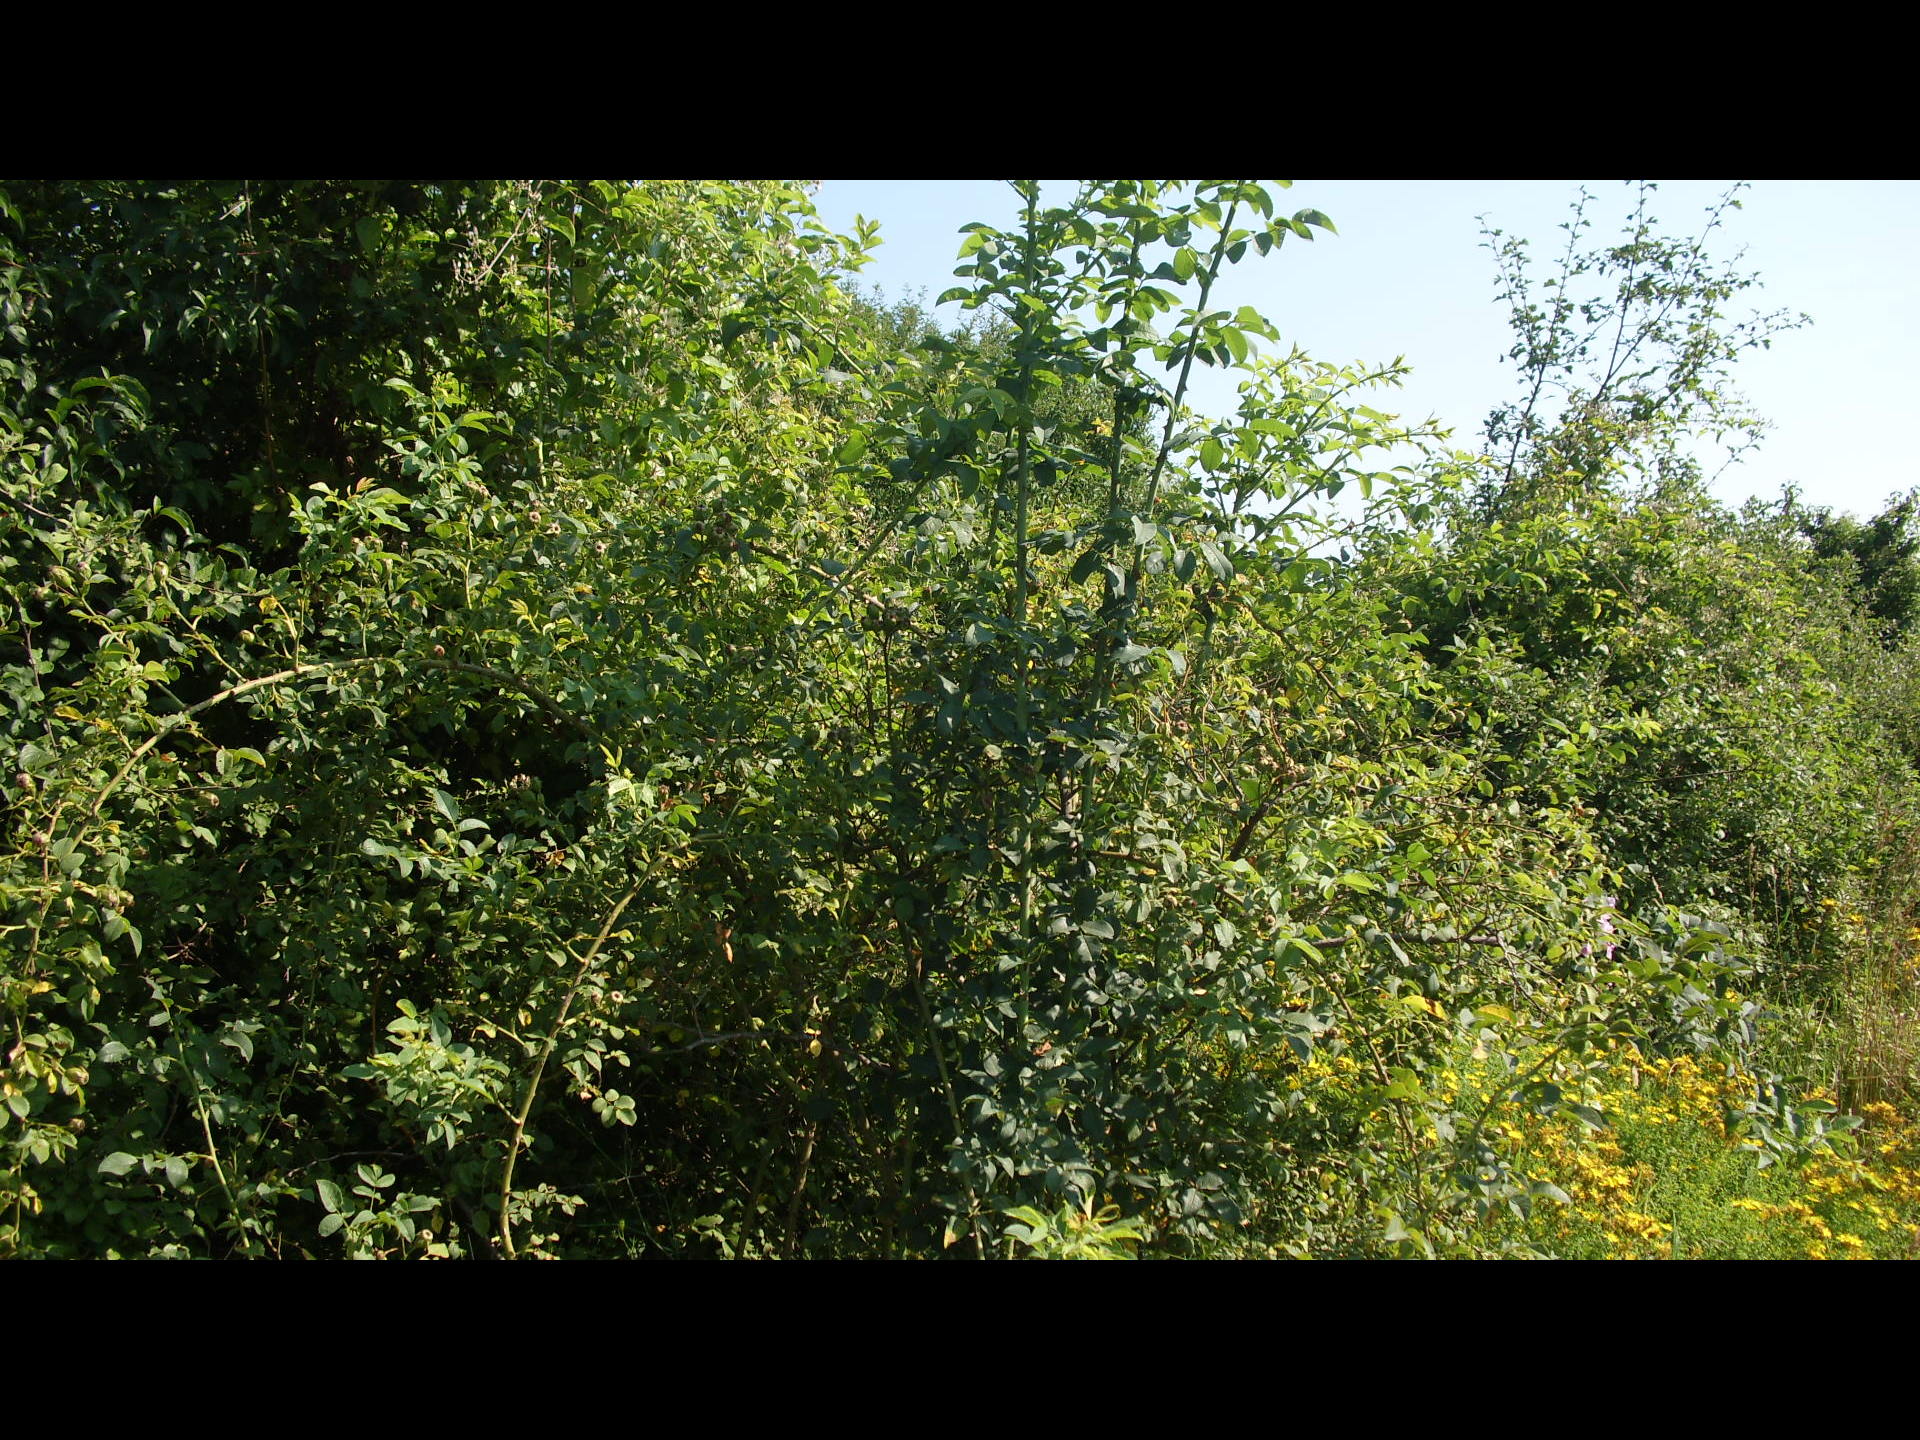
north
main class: Shrubland
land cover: Shrubland without tree cover
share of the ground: > 75 %
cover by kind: shrubs 85 %, herbaceous plants 15 %
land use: Semi-natural and natural areas not in use
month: July
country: BG
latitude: 43.7875
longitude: 22.9754
